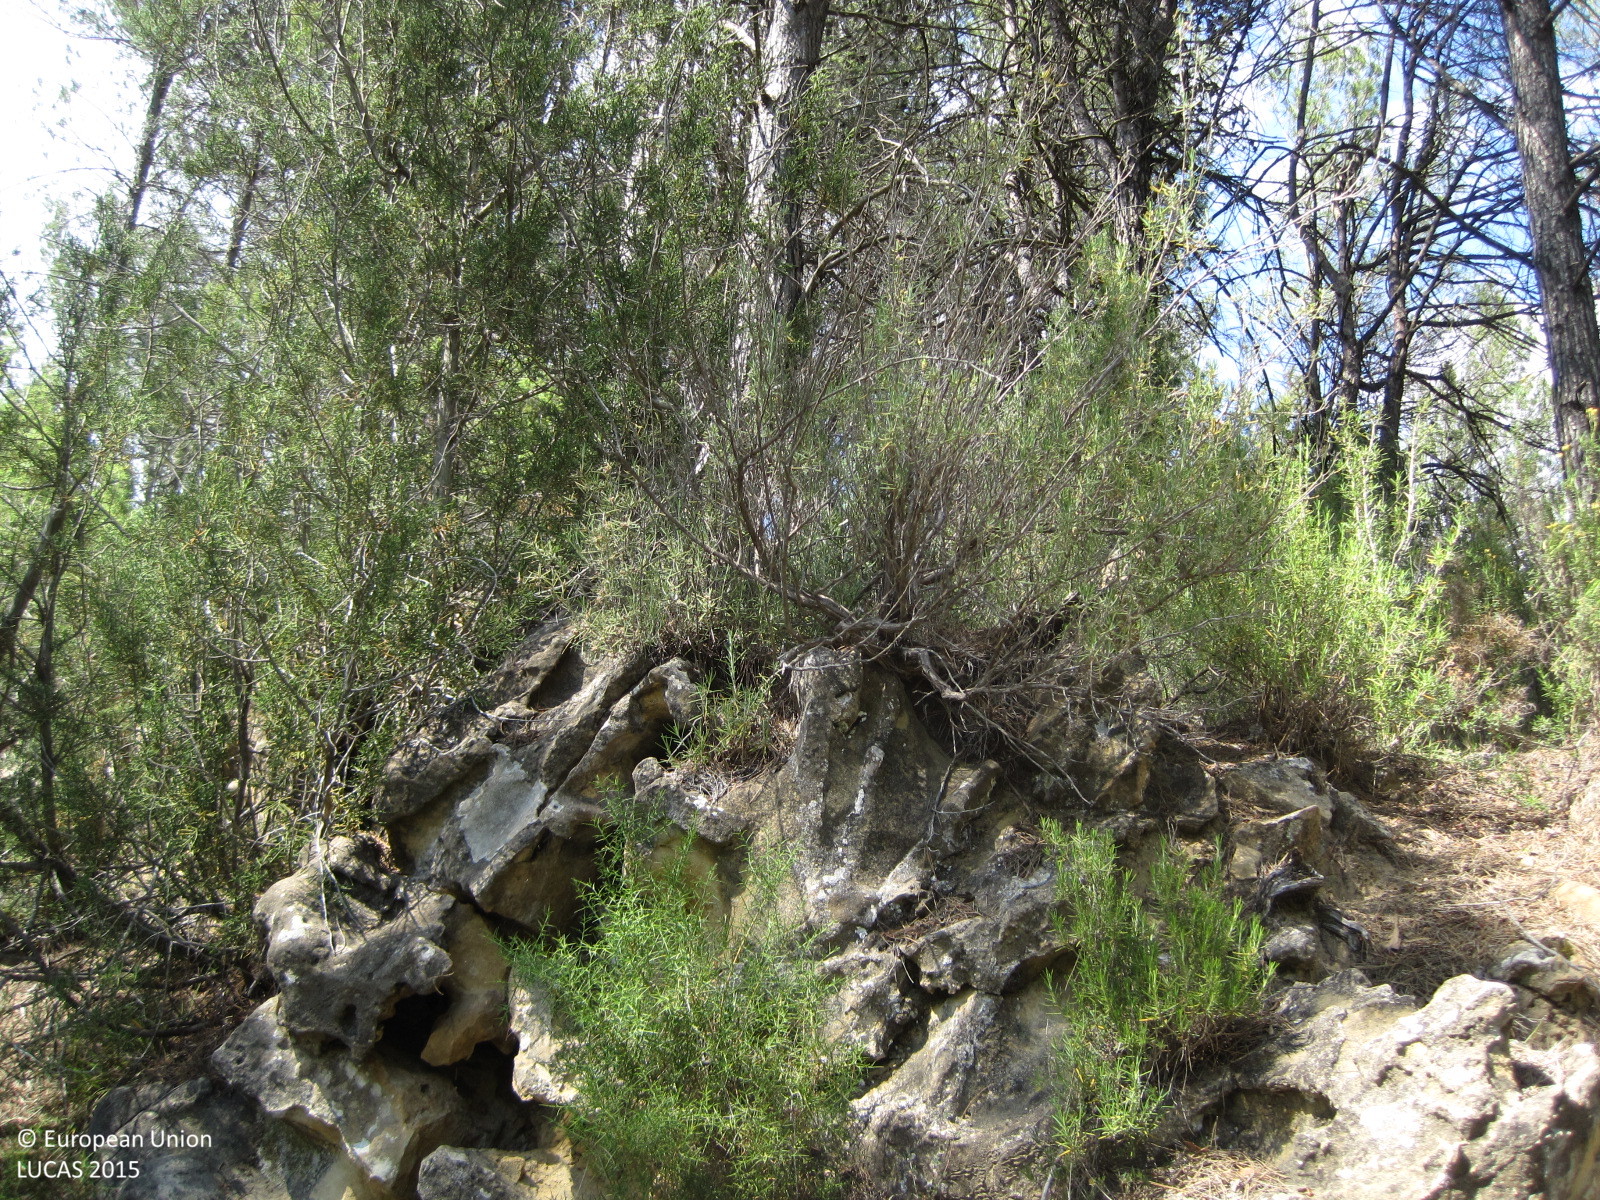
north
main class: Woodland
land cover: Pine dominated coniferous woodland
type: coniferous forest of the mediterranean region
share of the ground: 25 - 50 %
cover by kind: coniferous forest trees 40 %, shrubs 40 %, herbaceous plants 10 %, consolidated bare surface 10 %
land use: Forestry
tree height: > 5 m
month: June
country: ES
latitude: 39.7036
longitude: -1.1421
